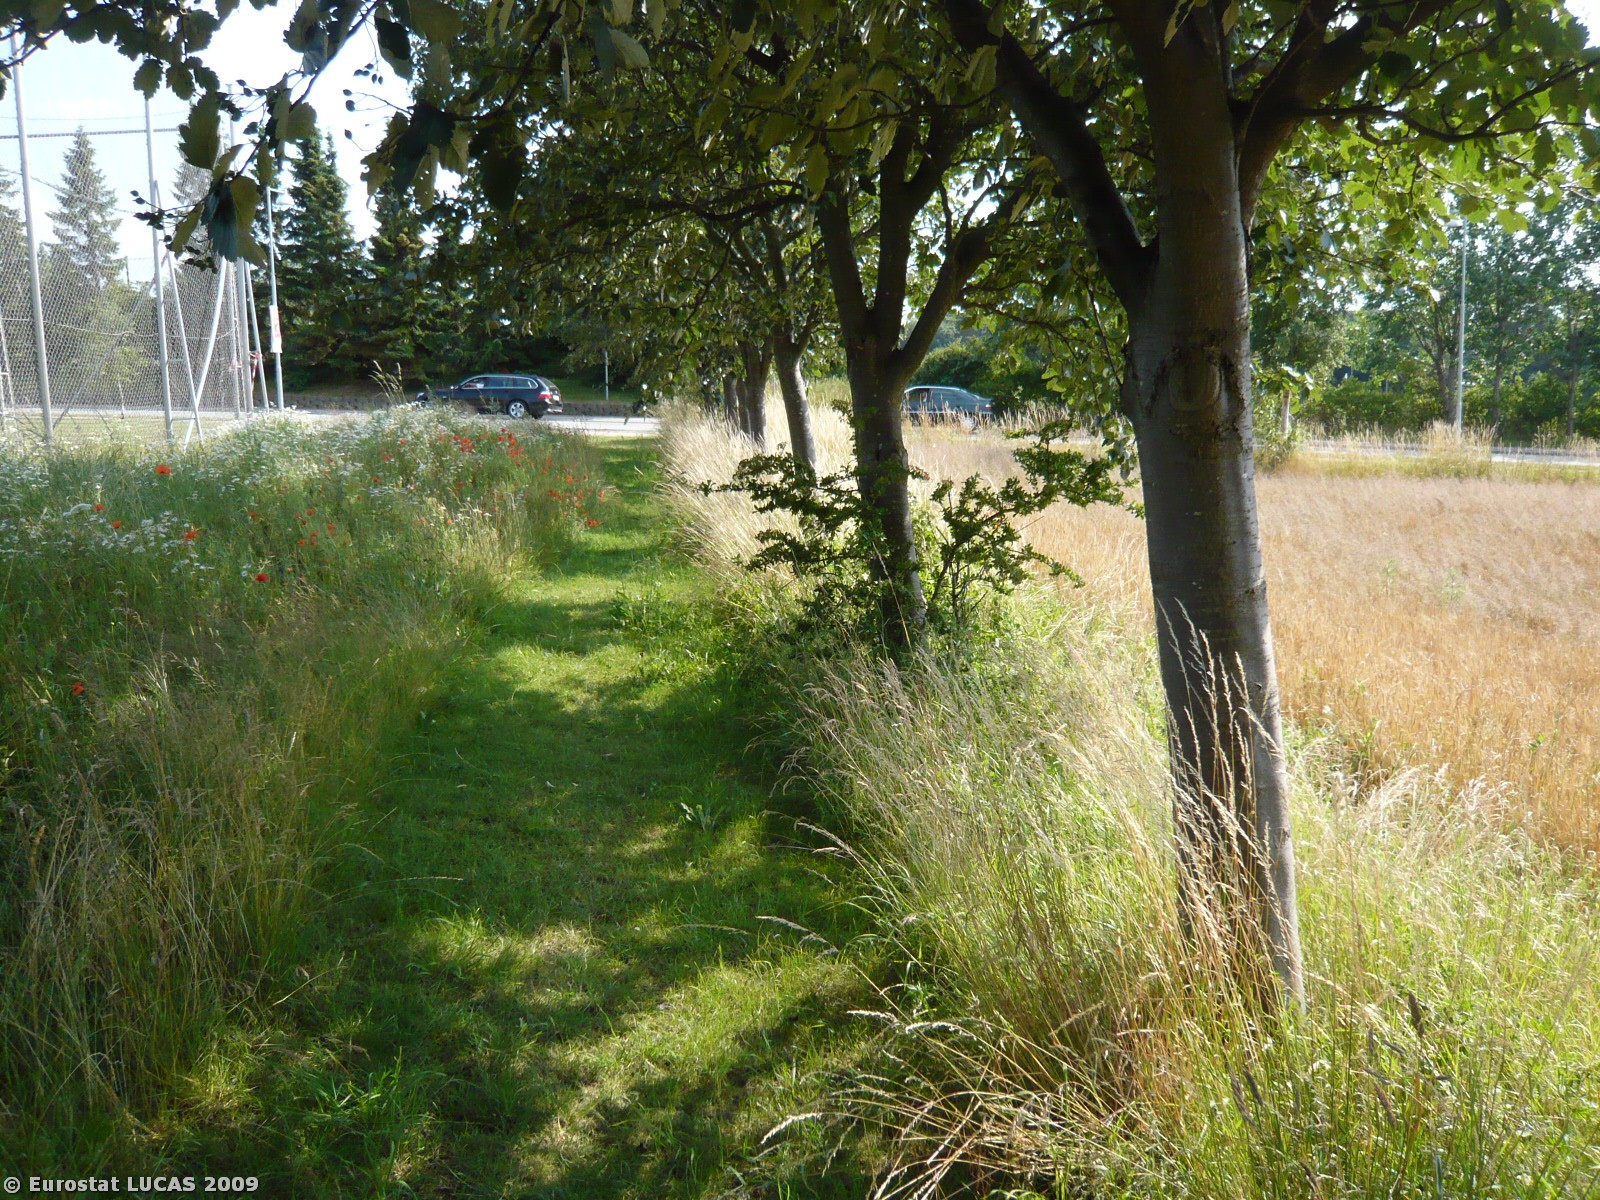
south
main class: Woodland
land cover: Broadleaved woodland
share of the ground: > 75 %
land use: Sport
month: July
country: DK
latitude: 55.9079
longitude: 11.6140
